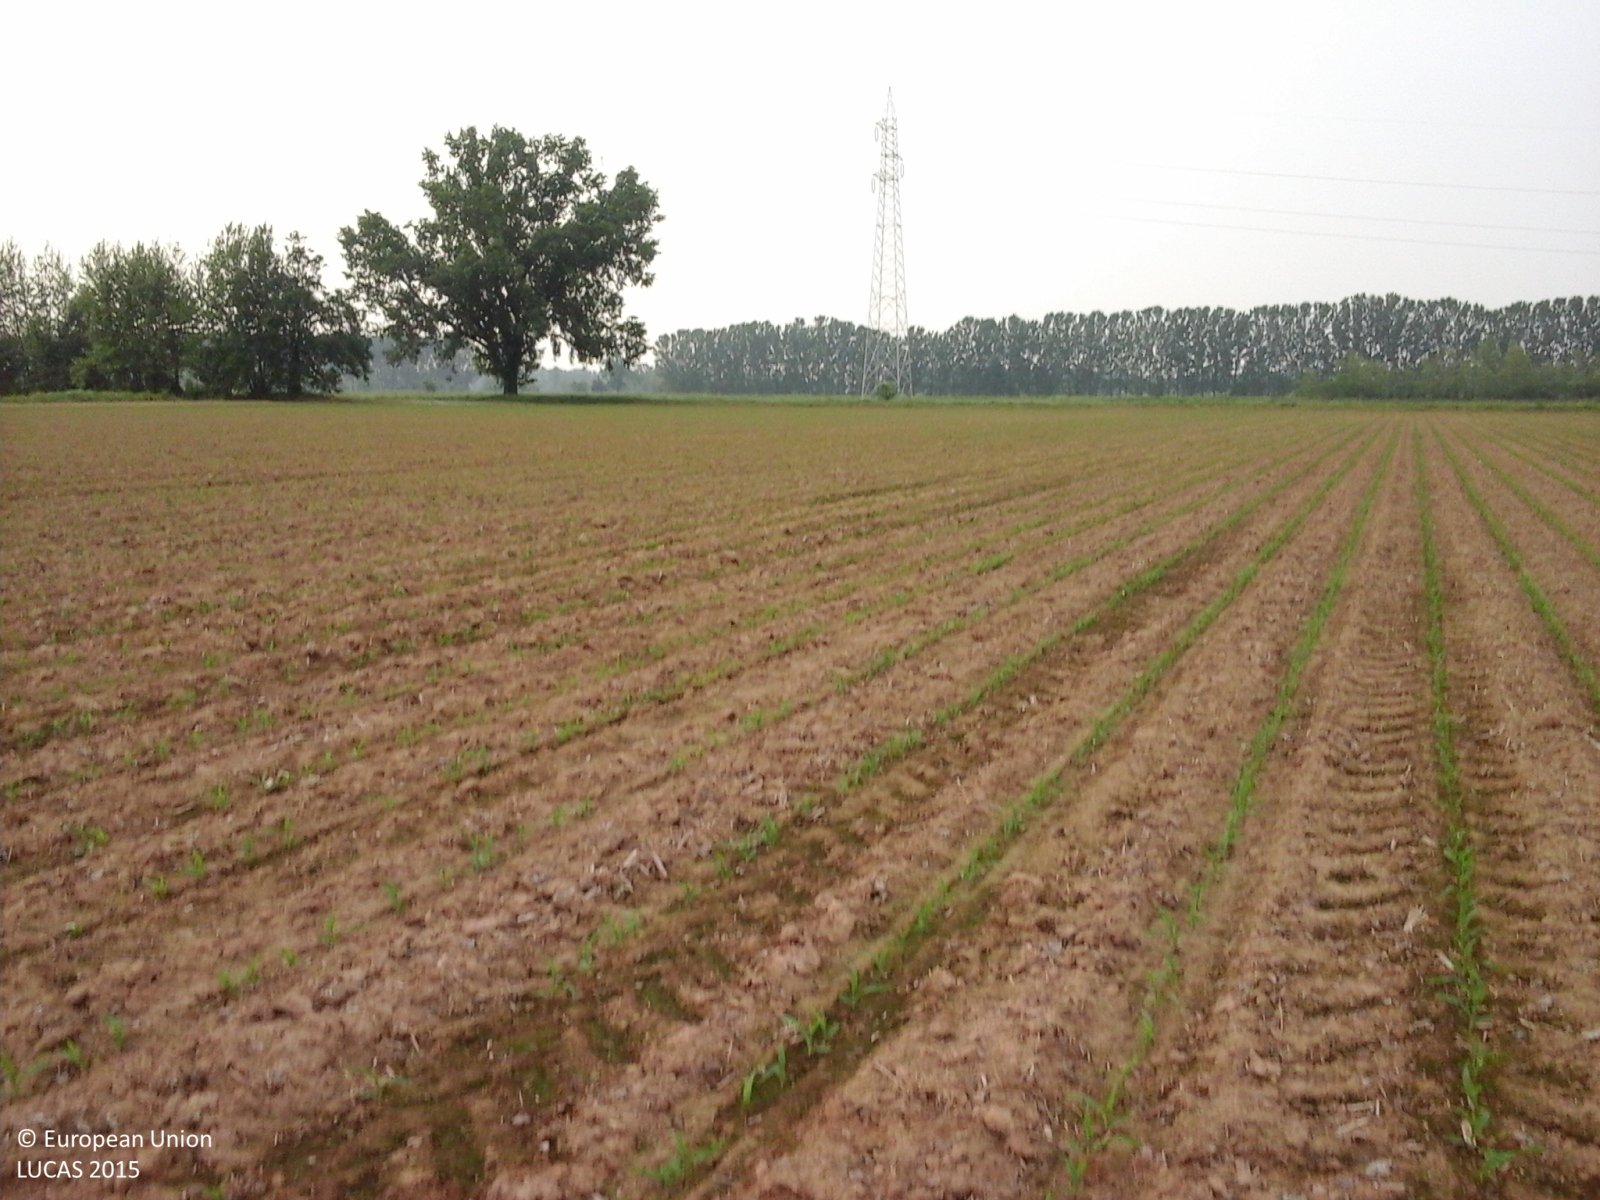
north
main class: Cropland
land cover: Maize
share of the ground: < 10 %
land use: Agriculture (excluding fallow land and kitchen gardens)
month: May
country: IT
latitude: 45.2340
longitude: 9.8601
